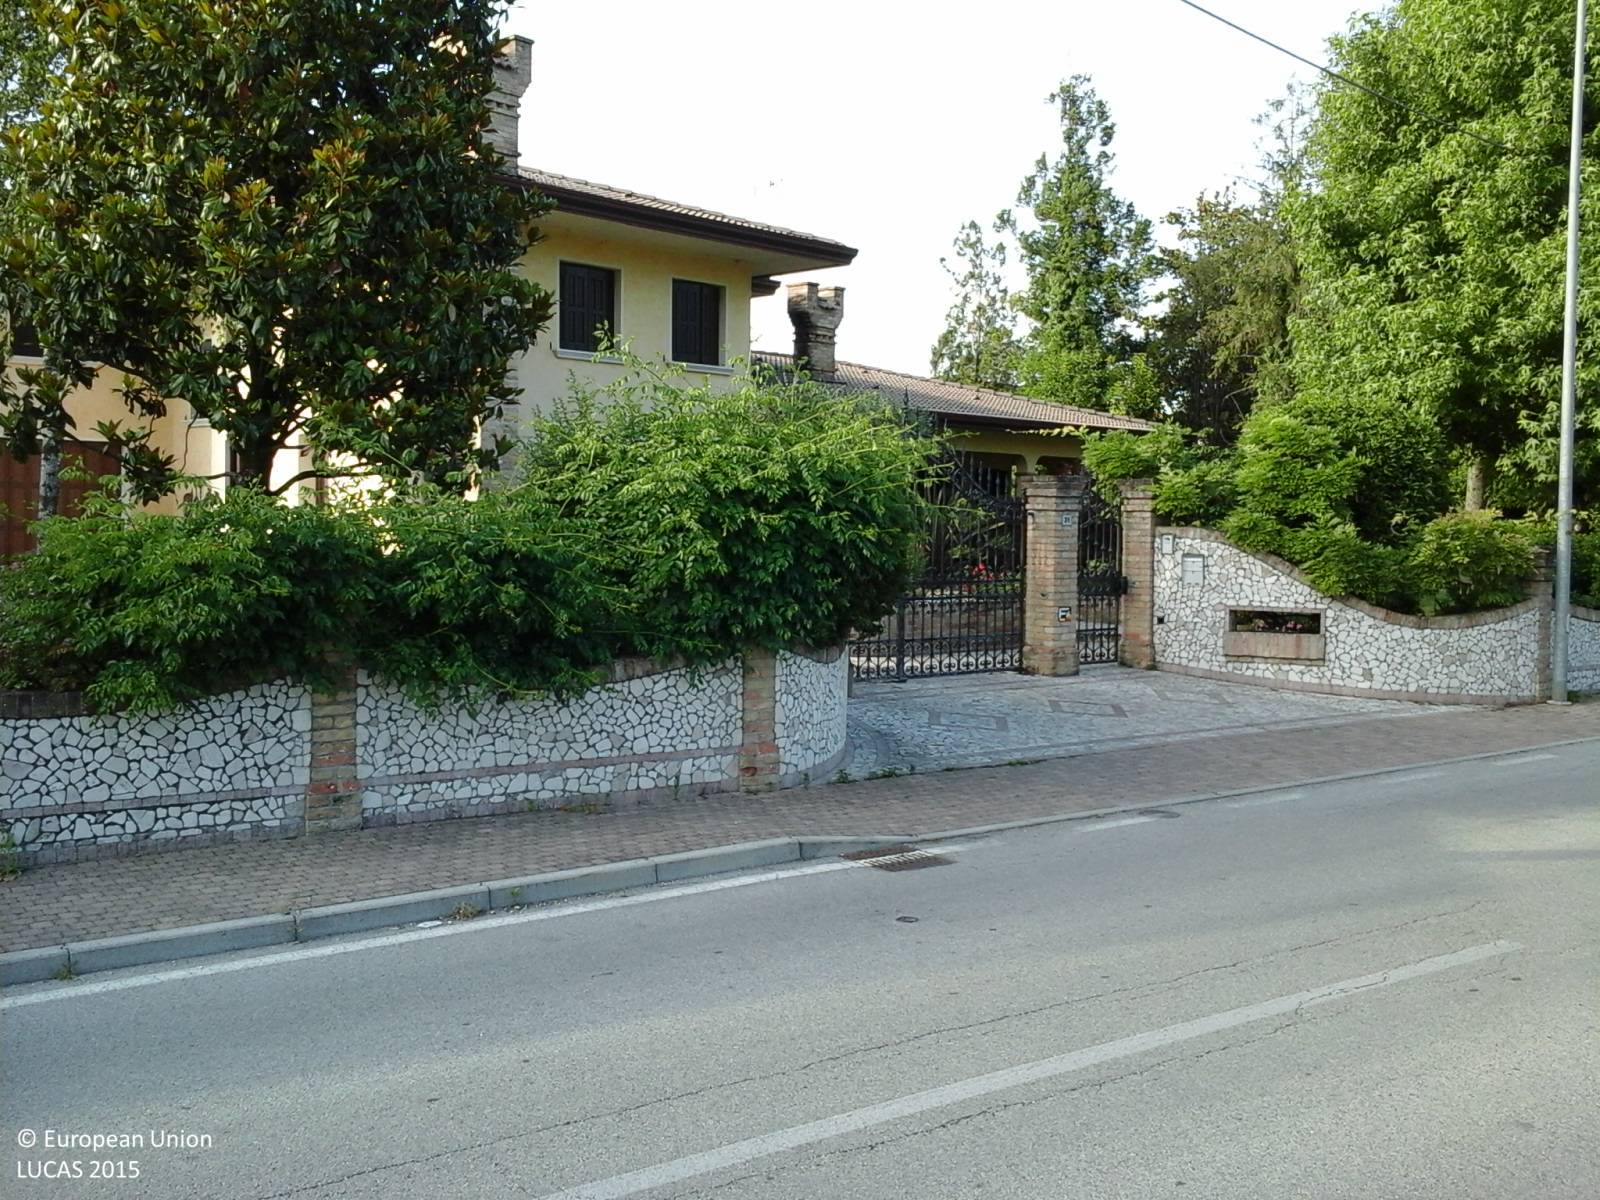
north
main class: Woodland
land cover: Broadleaved woodland
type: non-riverine alder, birch or aspen forest
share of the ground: > 75 %
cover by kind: broadleaved forest trees 100 %
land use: Residential
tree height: > 5 m
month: June
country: IT
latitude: 45.8488
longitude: 12.6878
